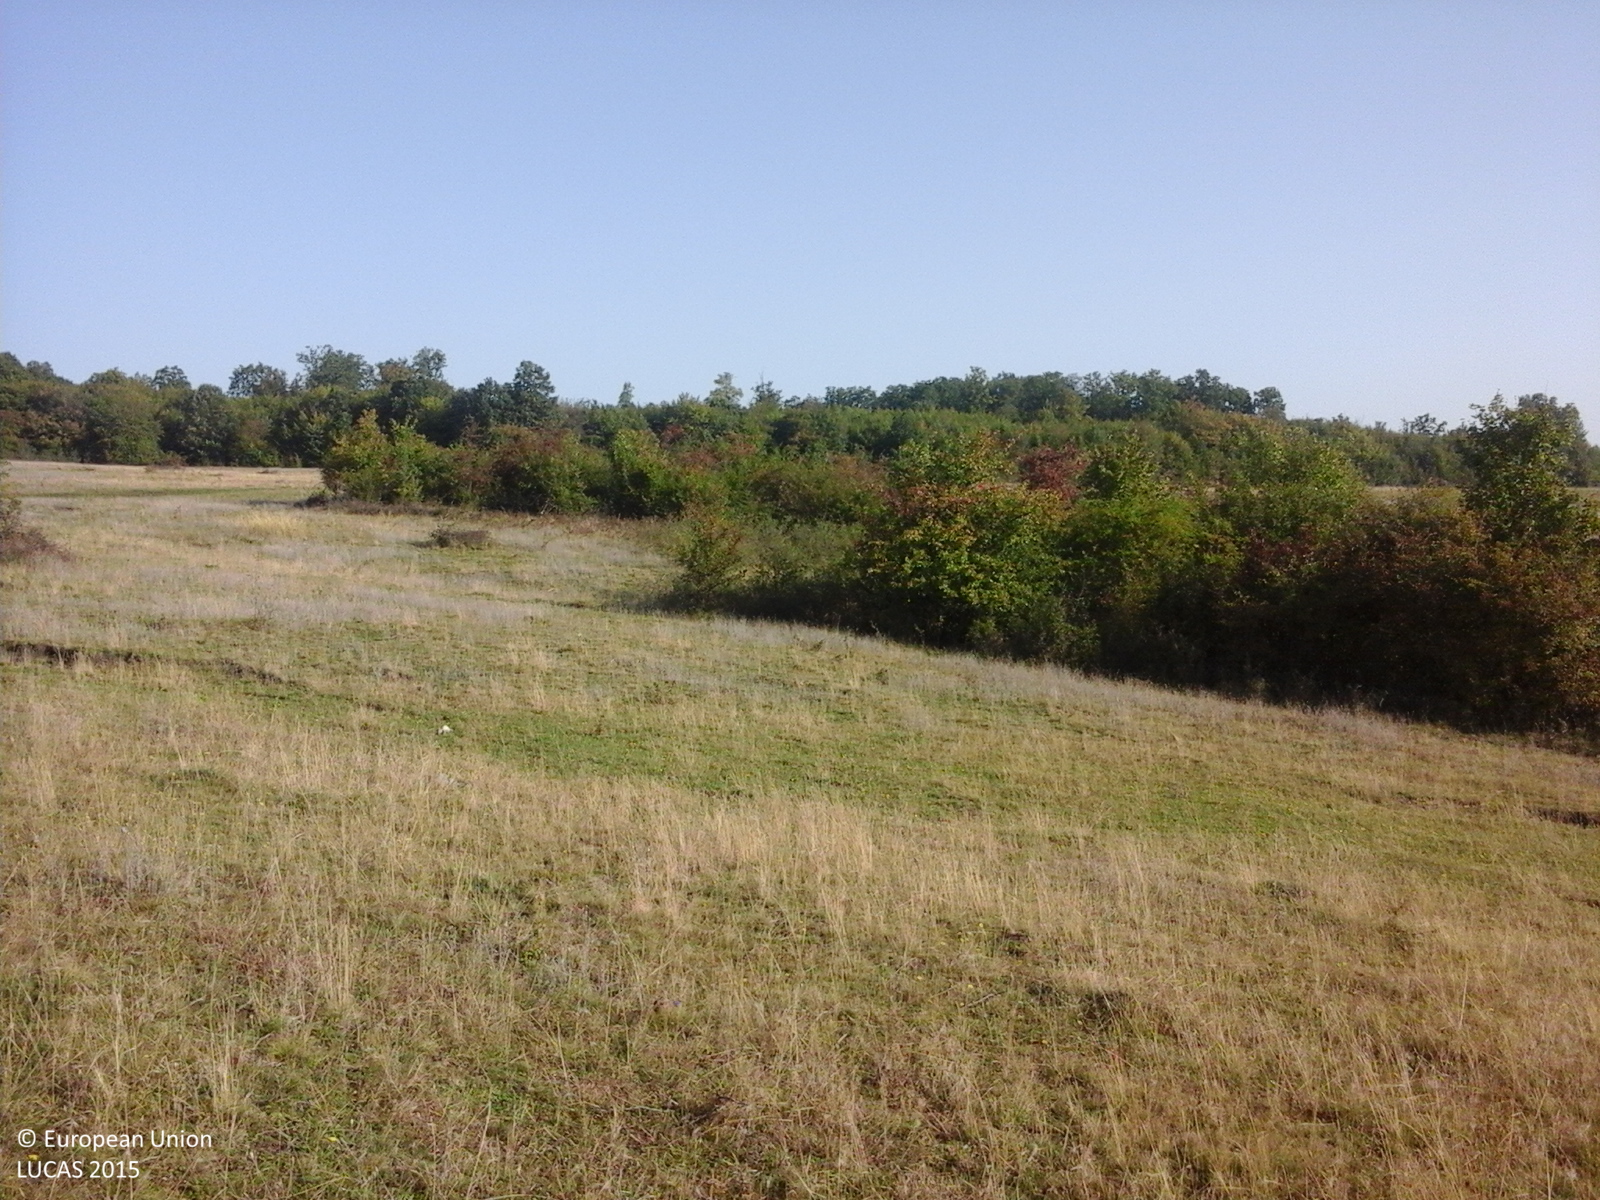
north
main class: Grassland
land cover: Grassland without tree/shrub cover
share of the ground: > 75 %
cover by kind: herbaceous plants 100 %
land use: Agriculture (excluding fallow land and kitchen gardens)
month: September
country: RO
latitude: 47.0530
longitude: 23.6997
